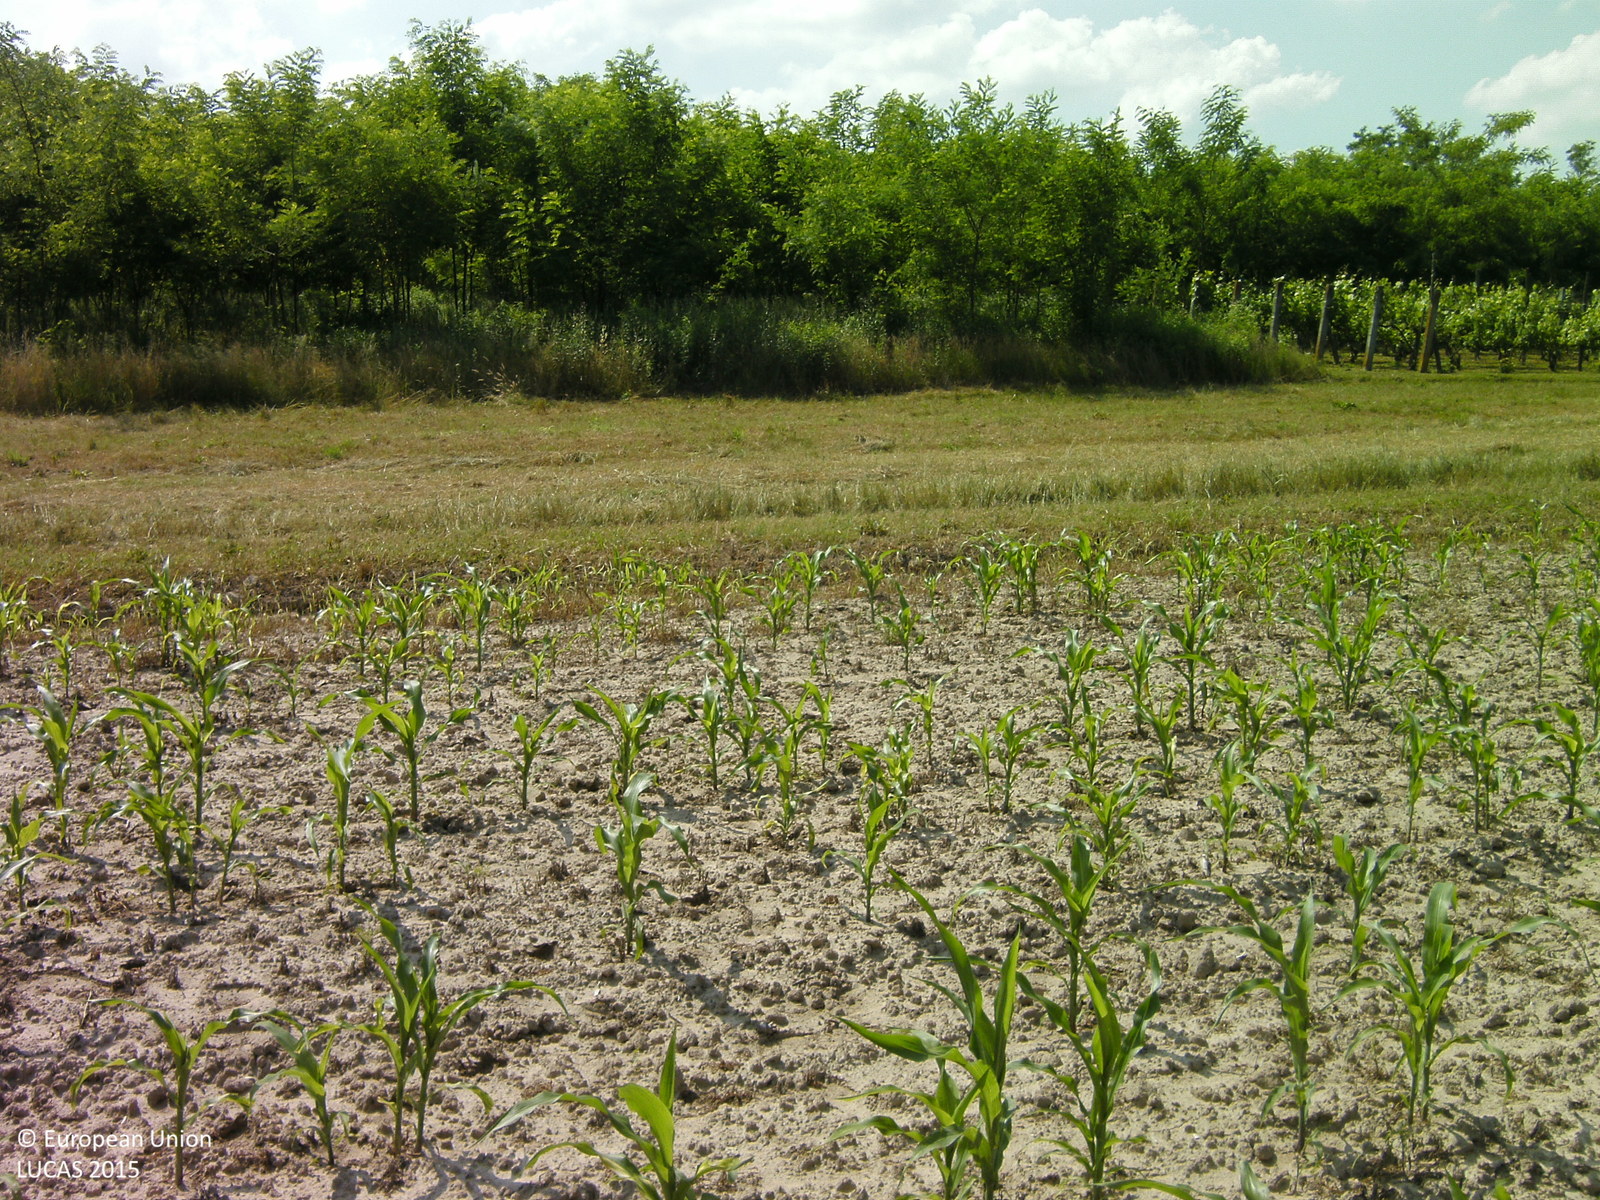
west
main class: Cropland
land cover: Maize
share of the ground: 10 - 25 %
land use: Agriculture (excluding fallow land and kitchen gardens)
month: June
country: HU
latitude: 46.4249
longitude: 17.5913
